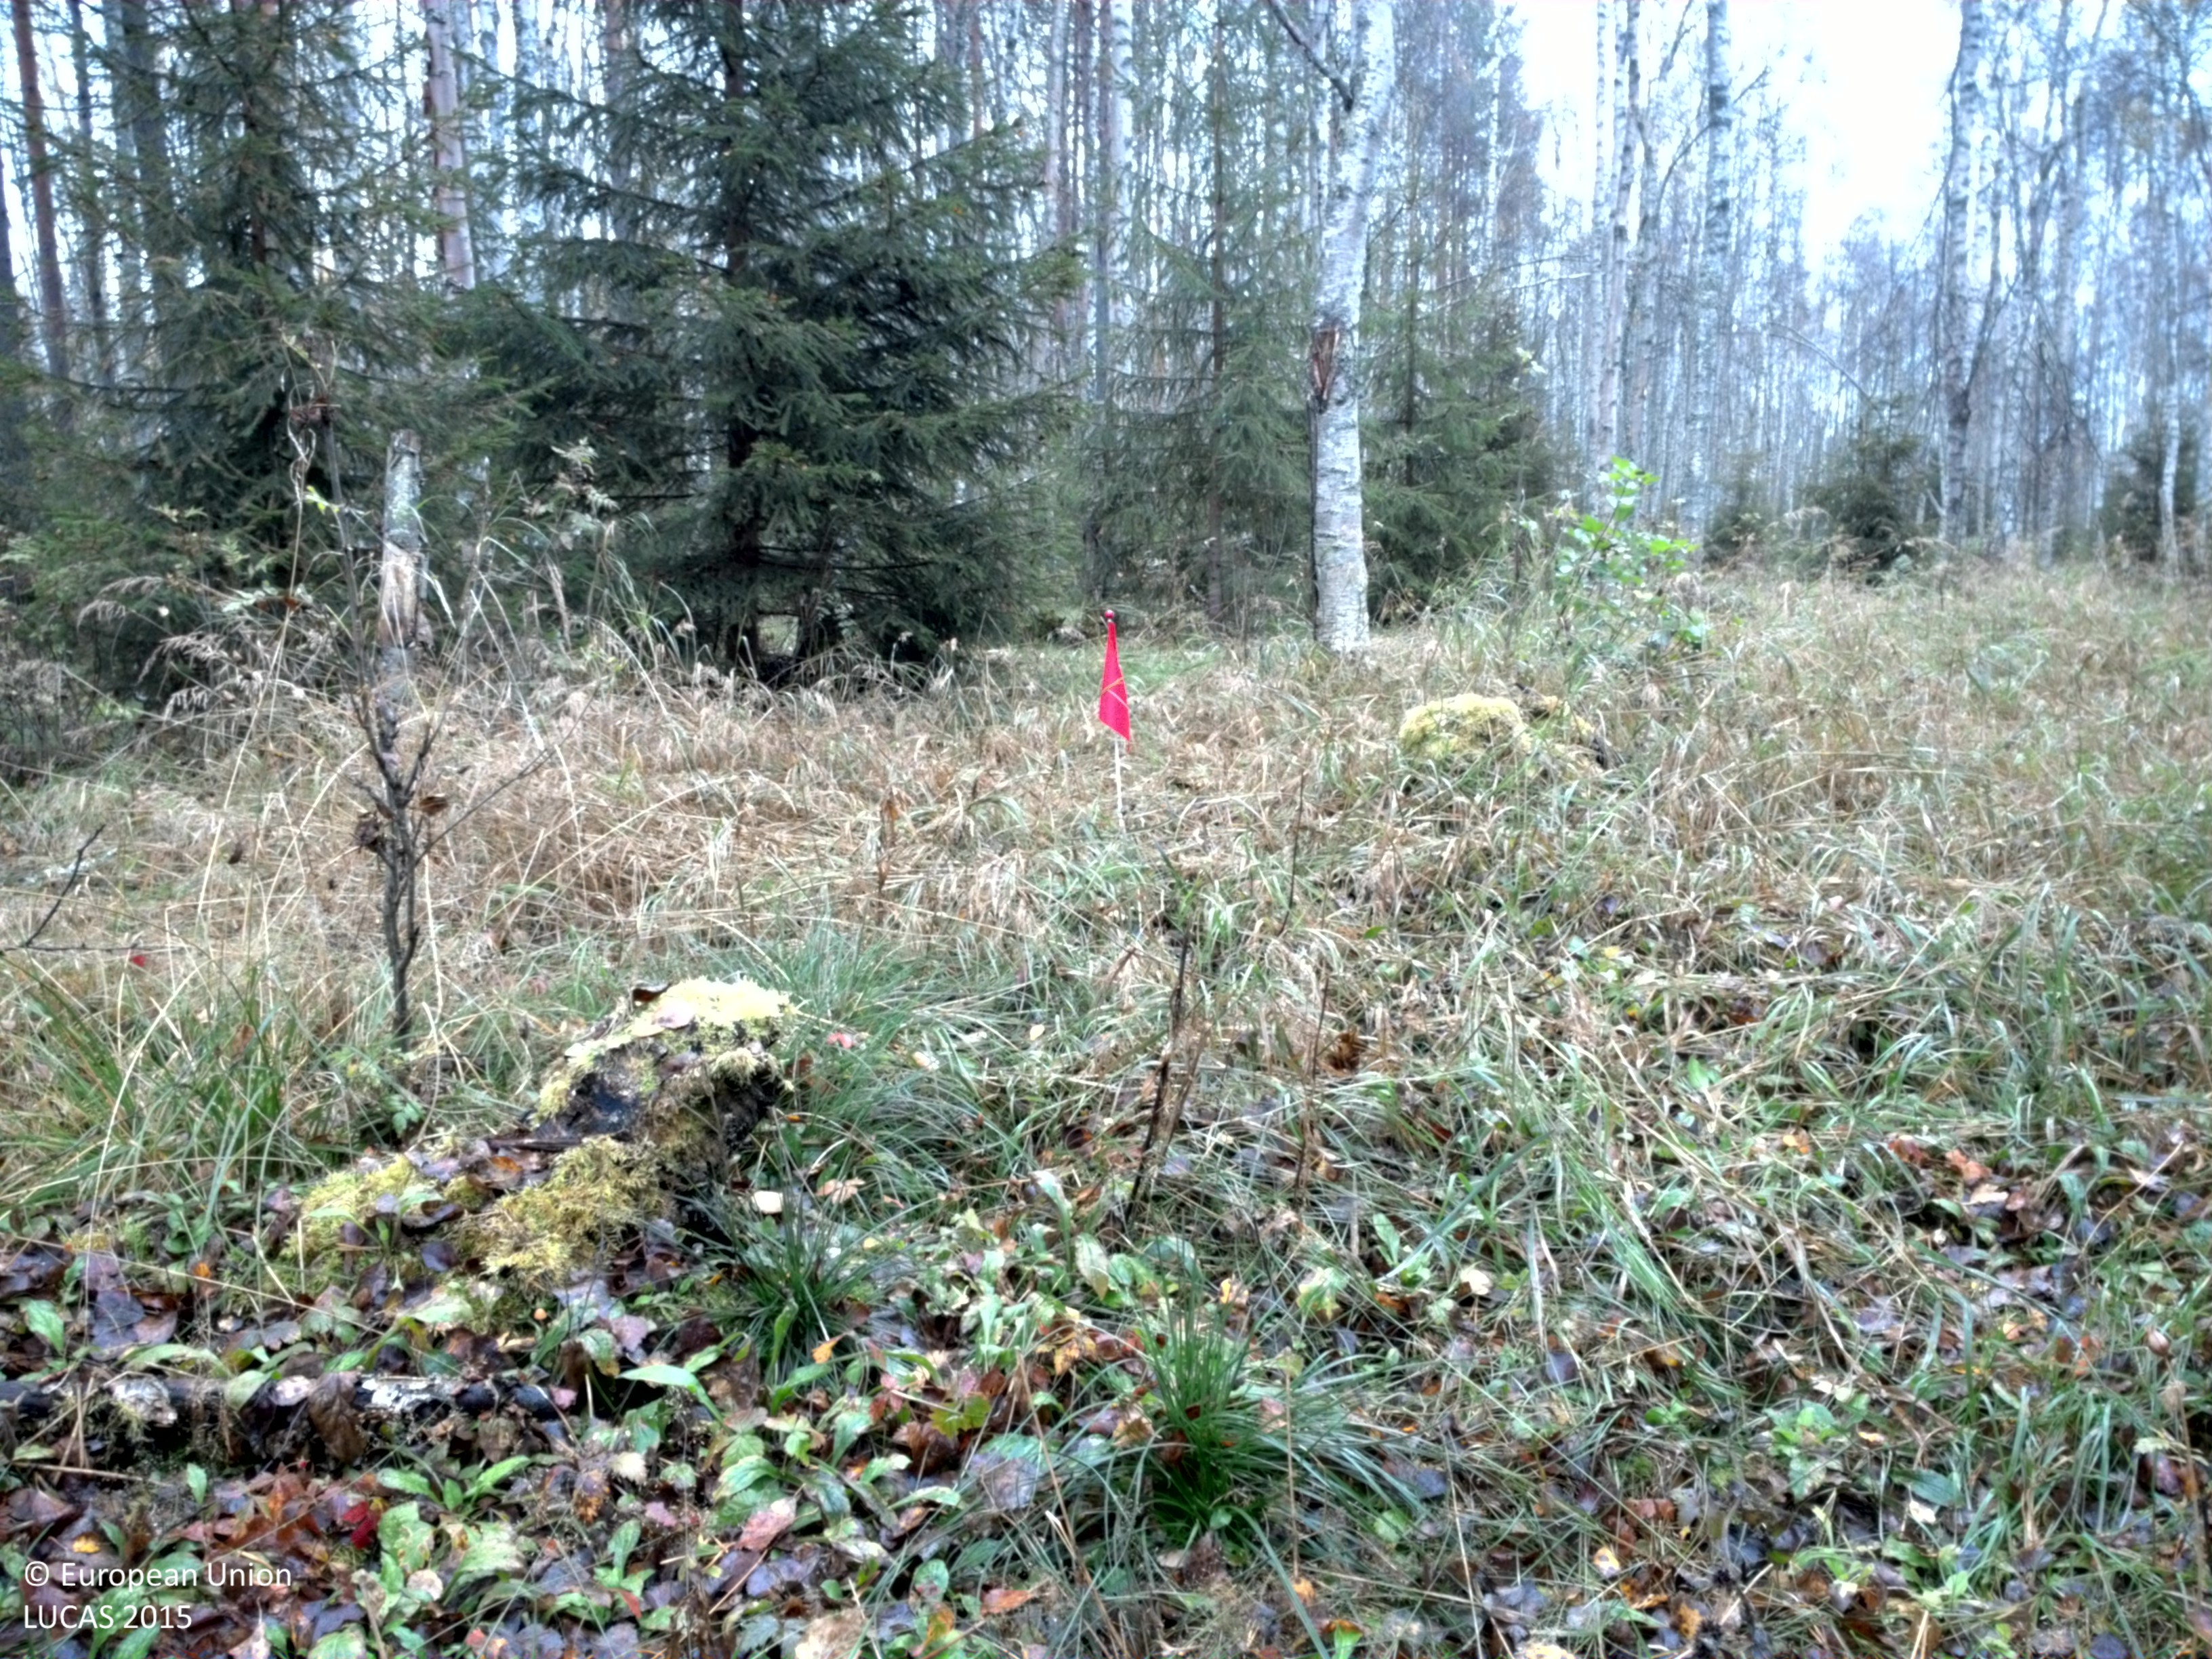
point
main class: Woodland
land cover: Broadleaved woodland
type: non-riverine alder, birch or aspen forest
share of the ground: 50 - 75 %
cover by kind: broadleaved forest trees 45 %, herbaceous plants 40 %, coniferous forest trees 10 %, shrubs 5 %
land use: Forestry
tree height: > 5 m
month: September
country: SE
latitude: 65.6633
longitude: 22.0033
